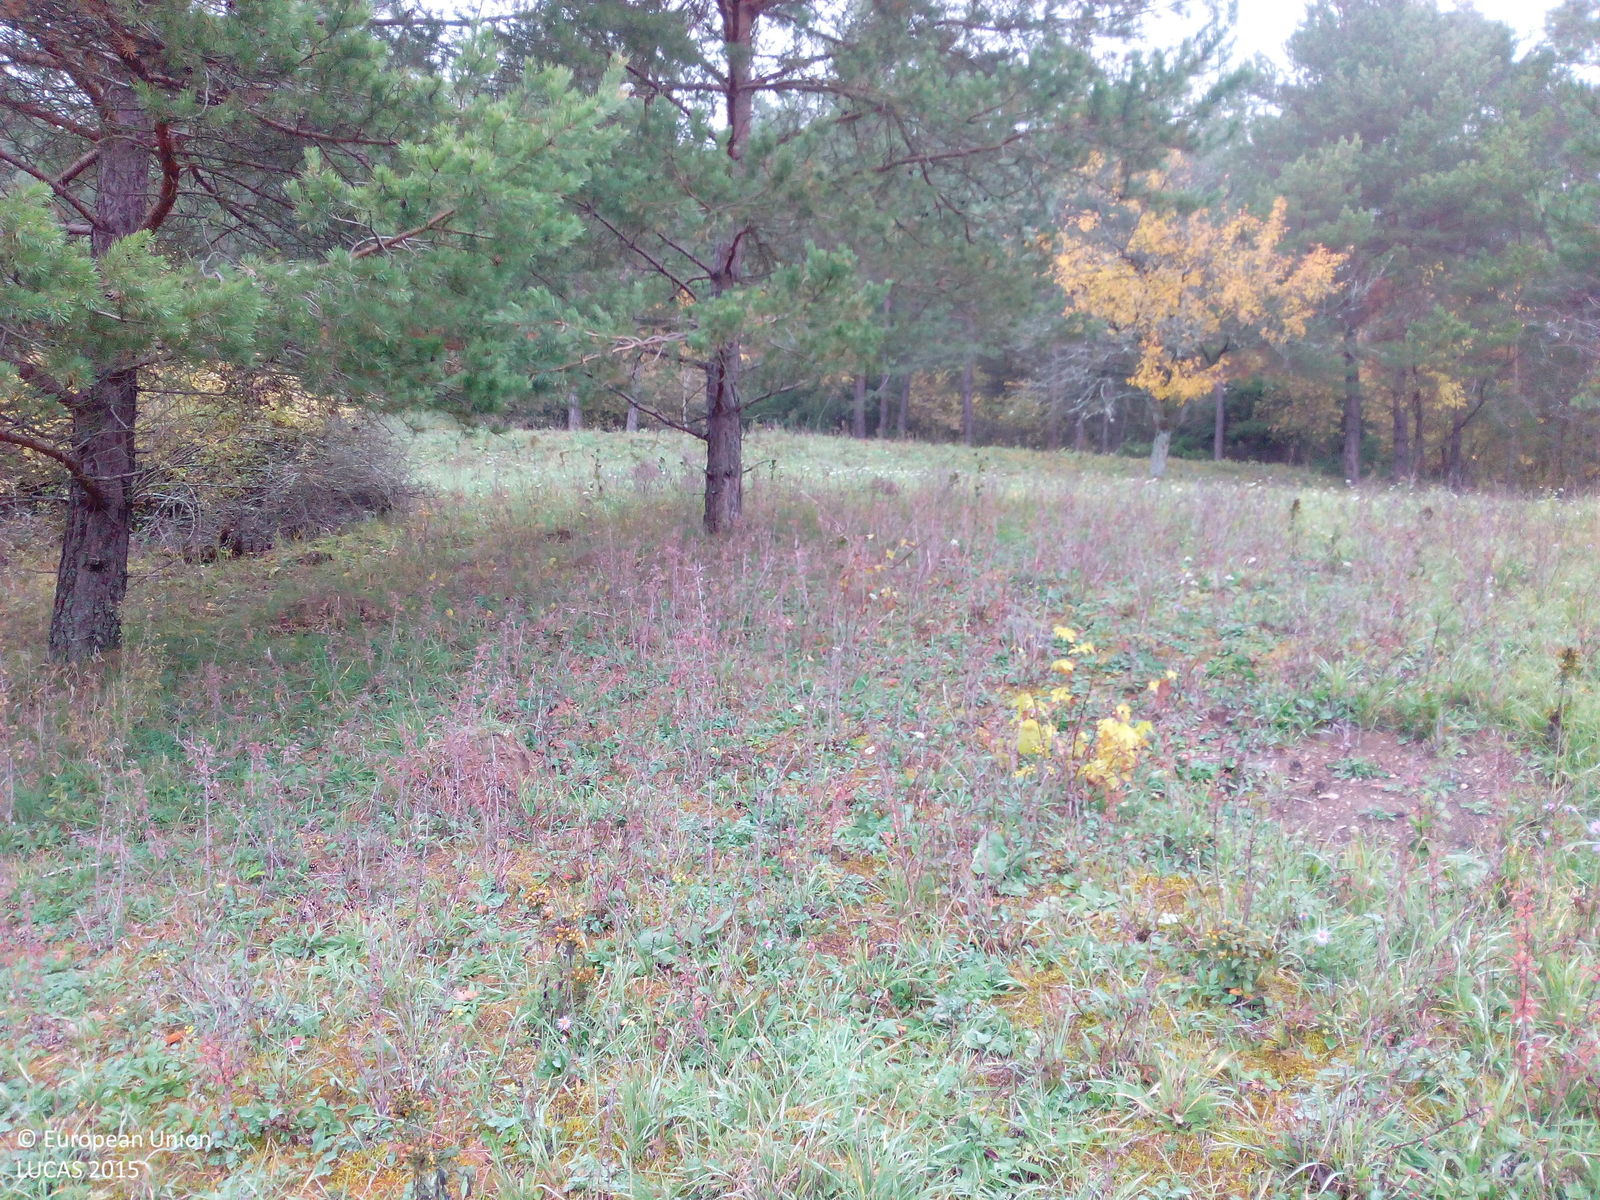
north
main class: Grassland
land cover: Grassland with sparse tree/shrub cover
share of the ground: > 75 %
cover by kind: herbaceous plants 90 %, coniferous forest trees 5 %, lichens and mosses 5 %
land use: Semi-natural and natural areas not in use
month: October
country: DE
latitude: 50.1482
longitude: 9.9301
